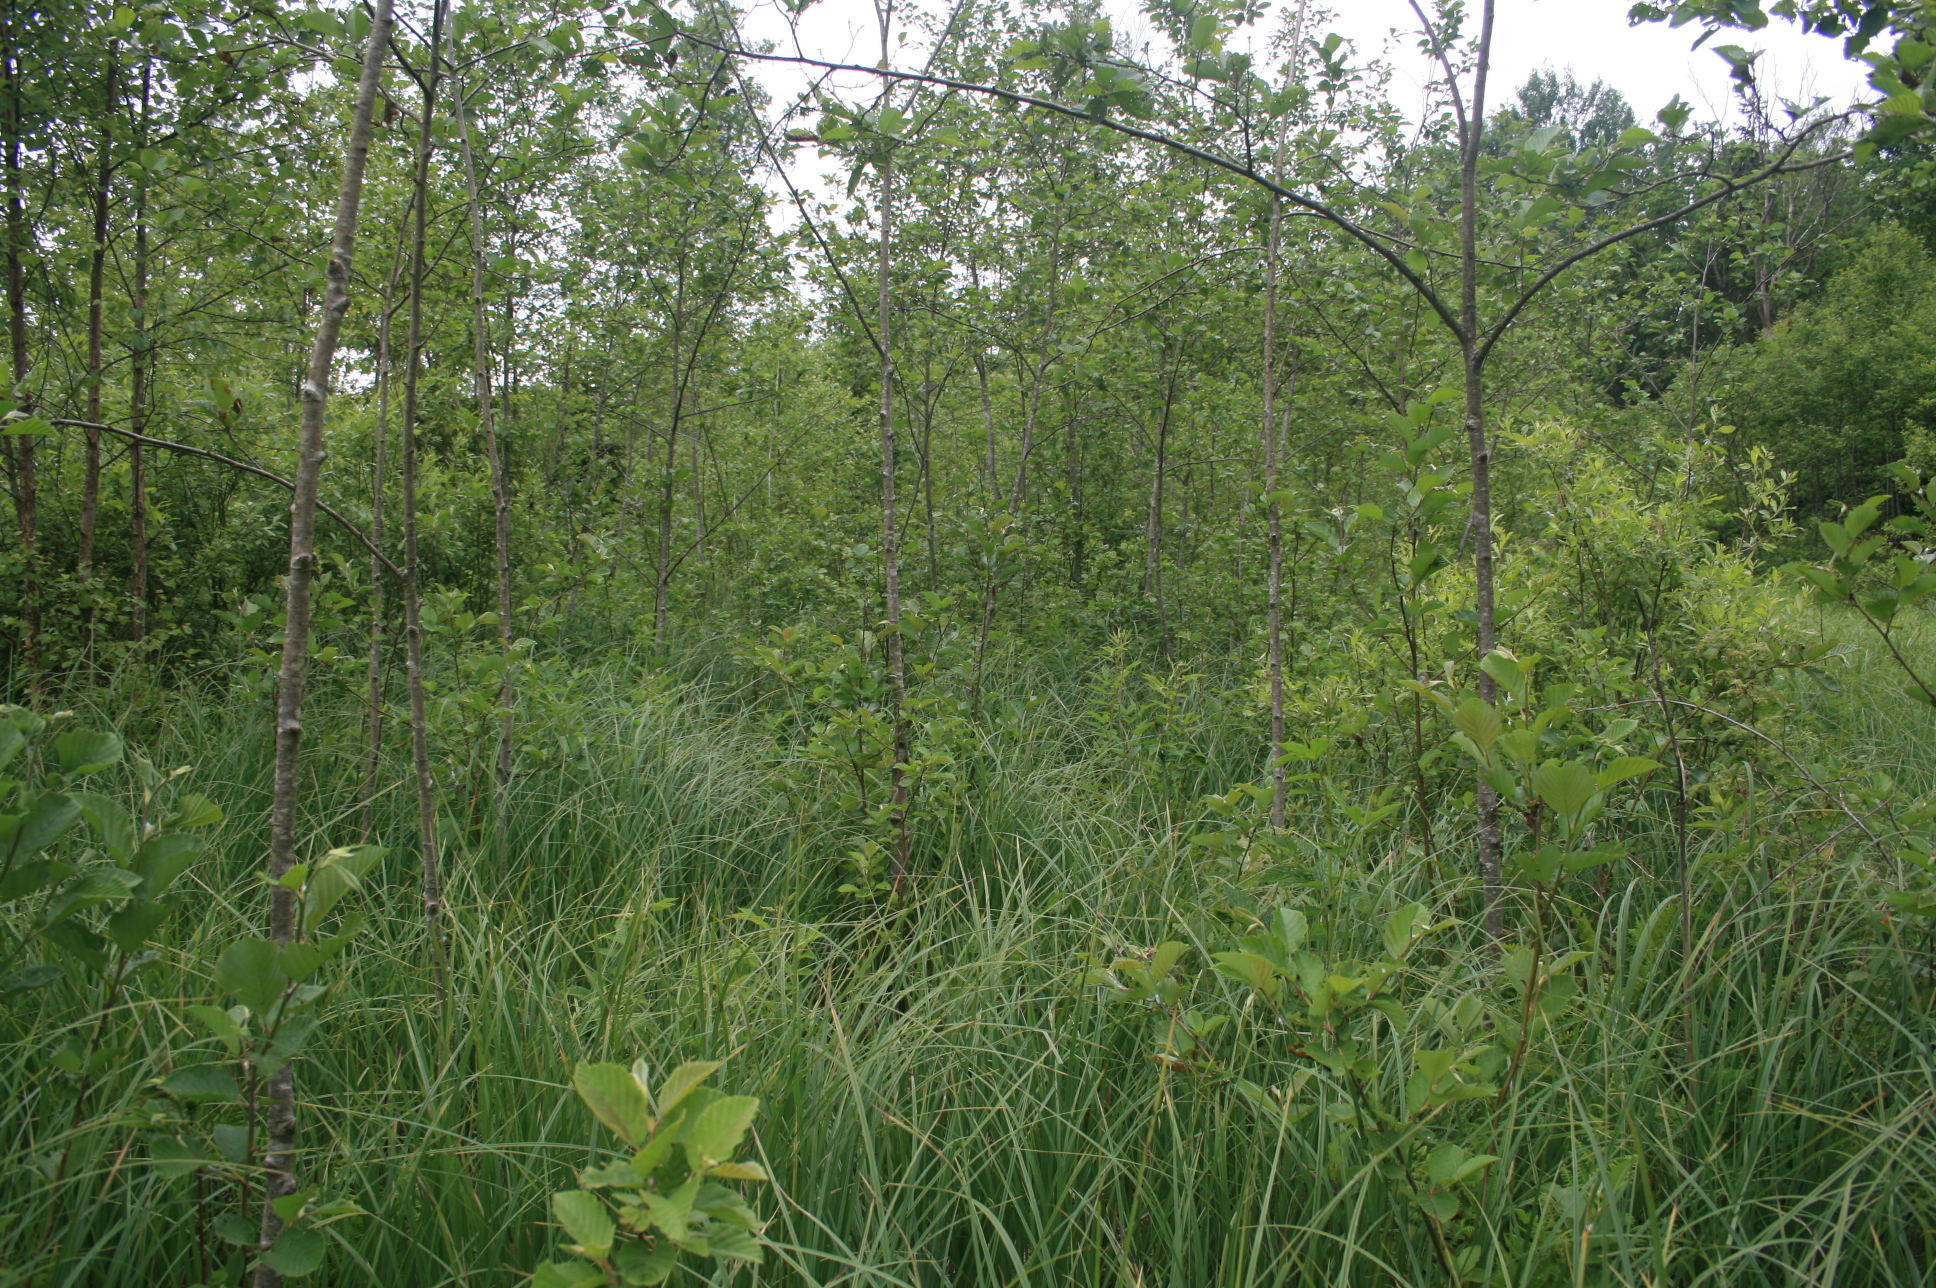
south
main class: Woodland
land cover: Broadleaved woodland
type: non-riverine alder, birch or aspen forest
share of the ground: 50 - 75 %
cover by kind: broadleaved forest trees 60 %, herbaceous plants 40 %
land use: Forestry
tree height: < 5 m
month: June
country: LT
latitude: 55.5495
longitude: 22.3747
